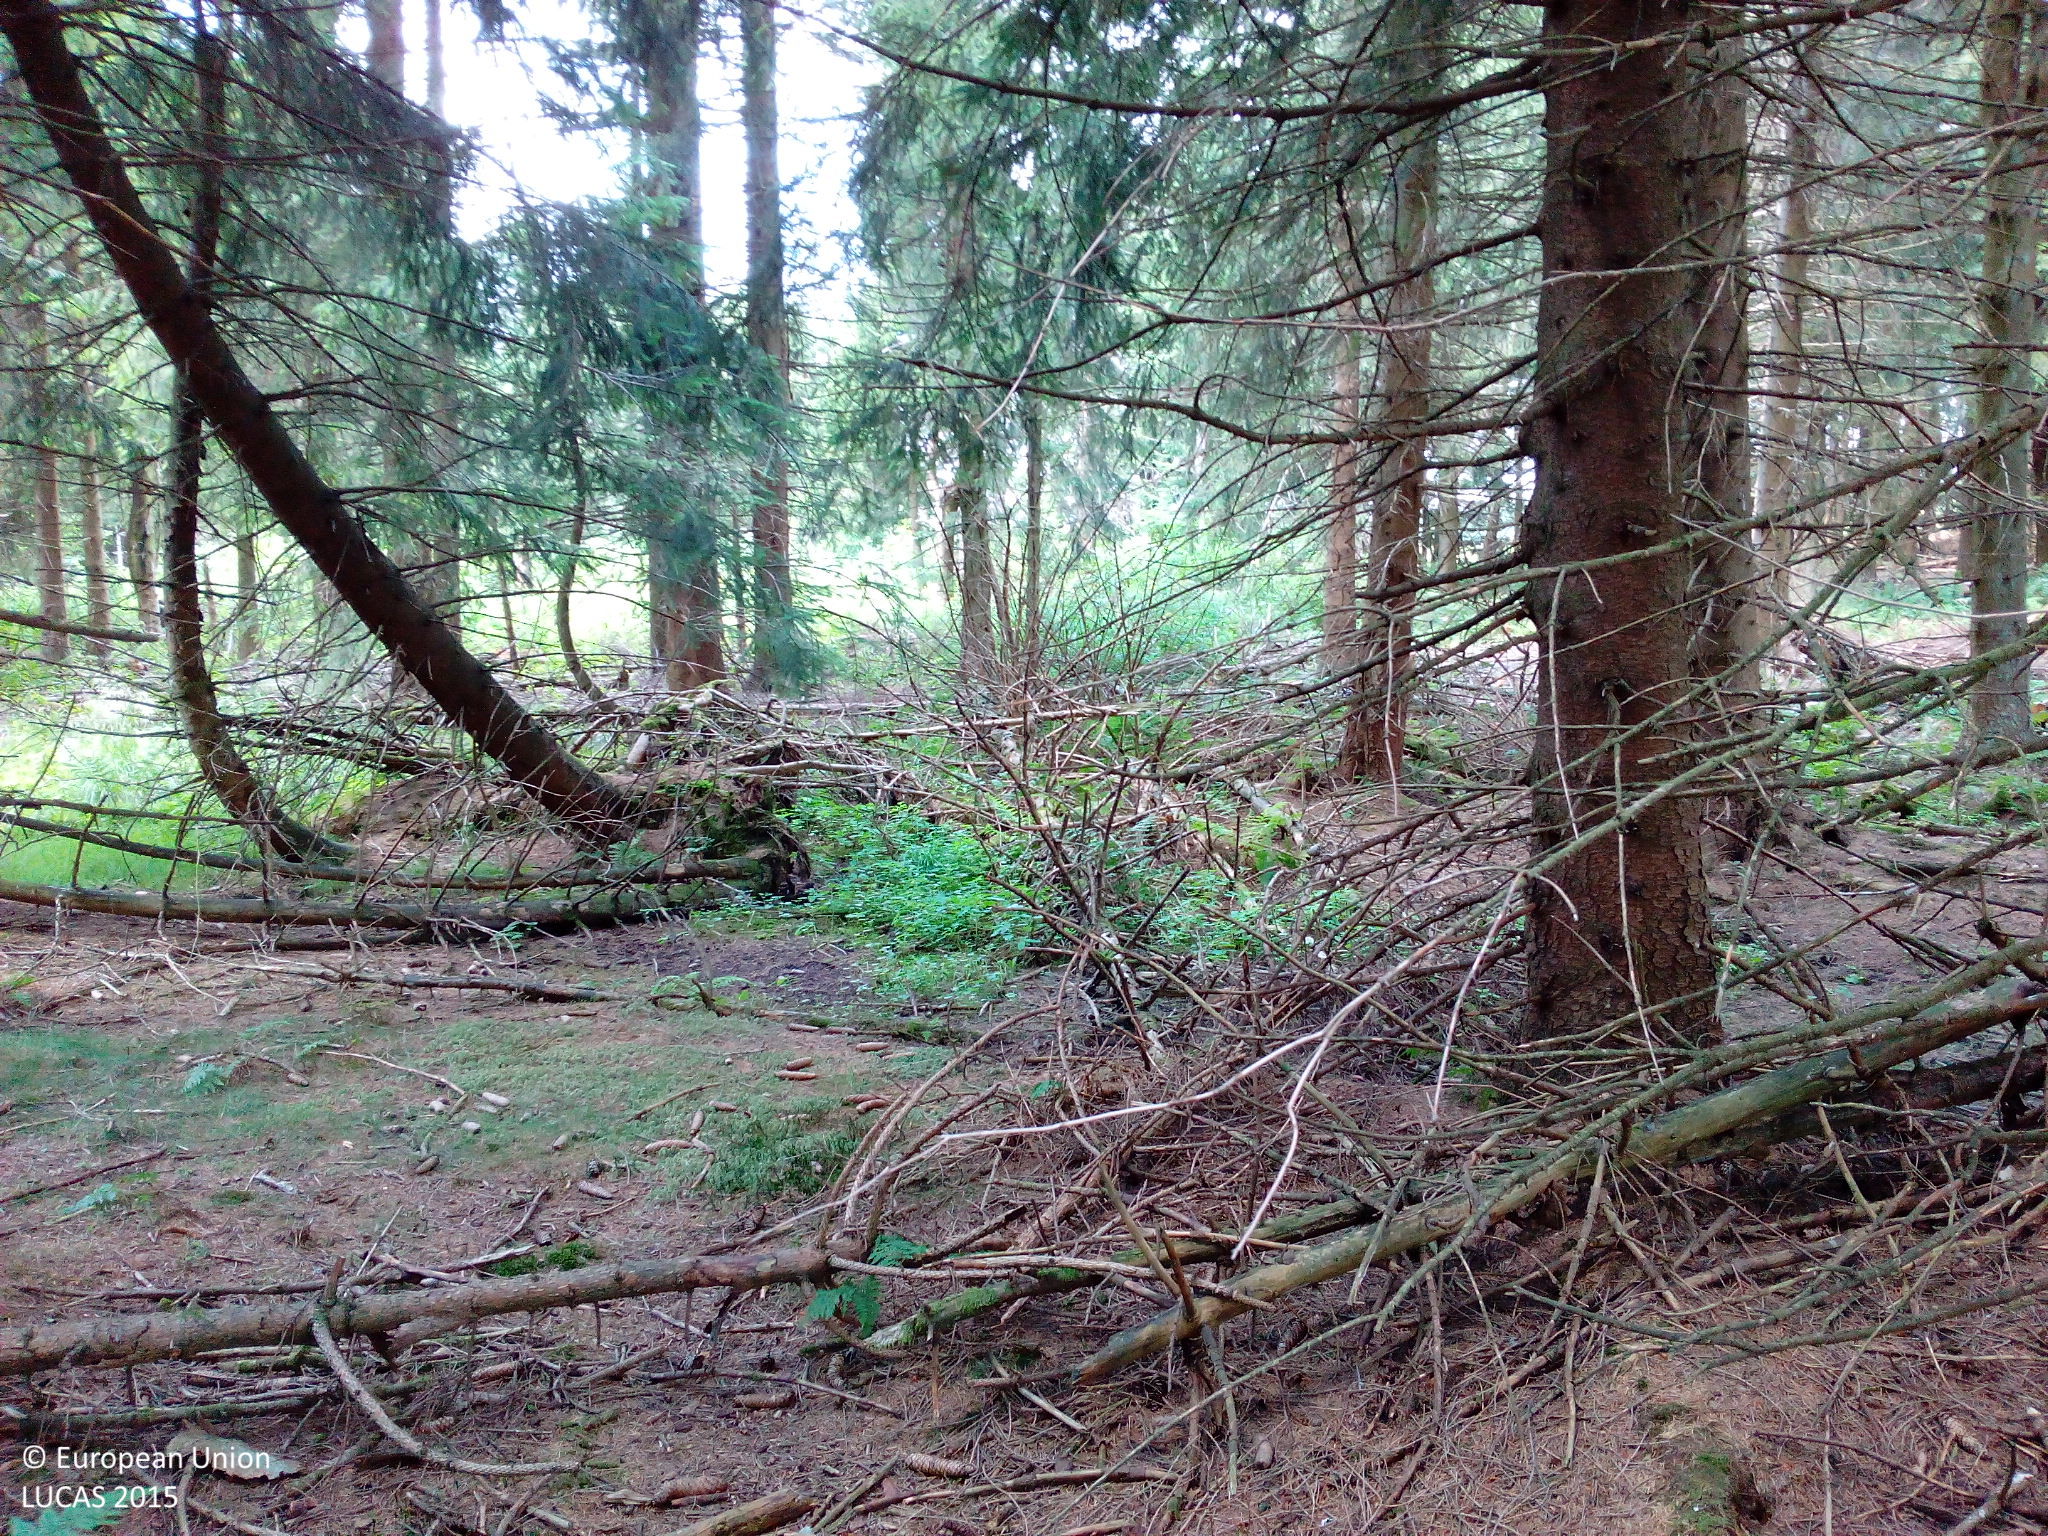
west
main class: Woodland
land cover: Spruce dominated coniferous woodland
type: hemiboreal forest and nemoral coniferous forest and mixed broadleaved-coniferous forest
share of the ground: > 75 %
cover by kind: coniferous forest trees 95 %, herbaceous plants 5 %
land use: Forestry
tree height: > 5 m
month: July
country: DE
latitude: 50.4899
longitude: 9.9577
